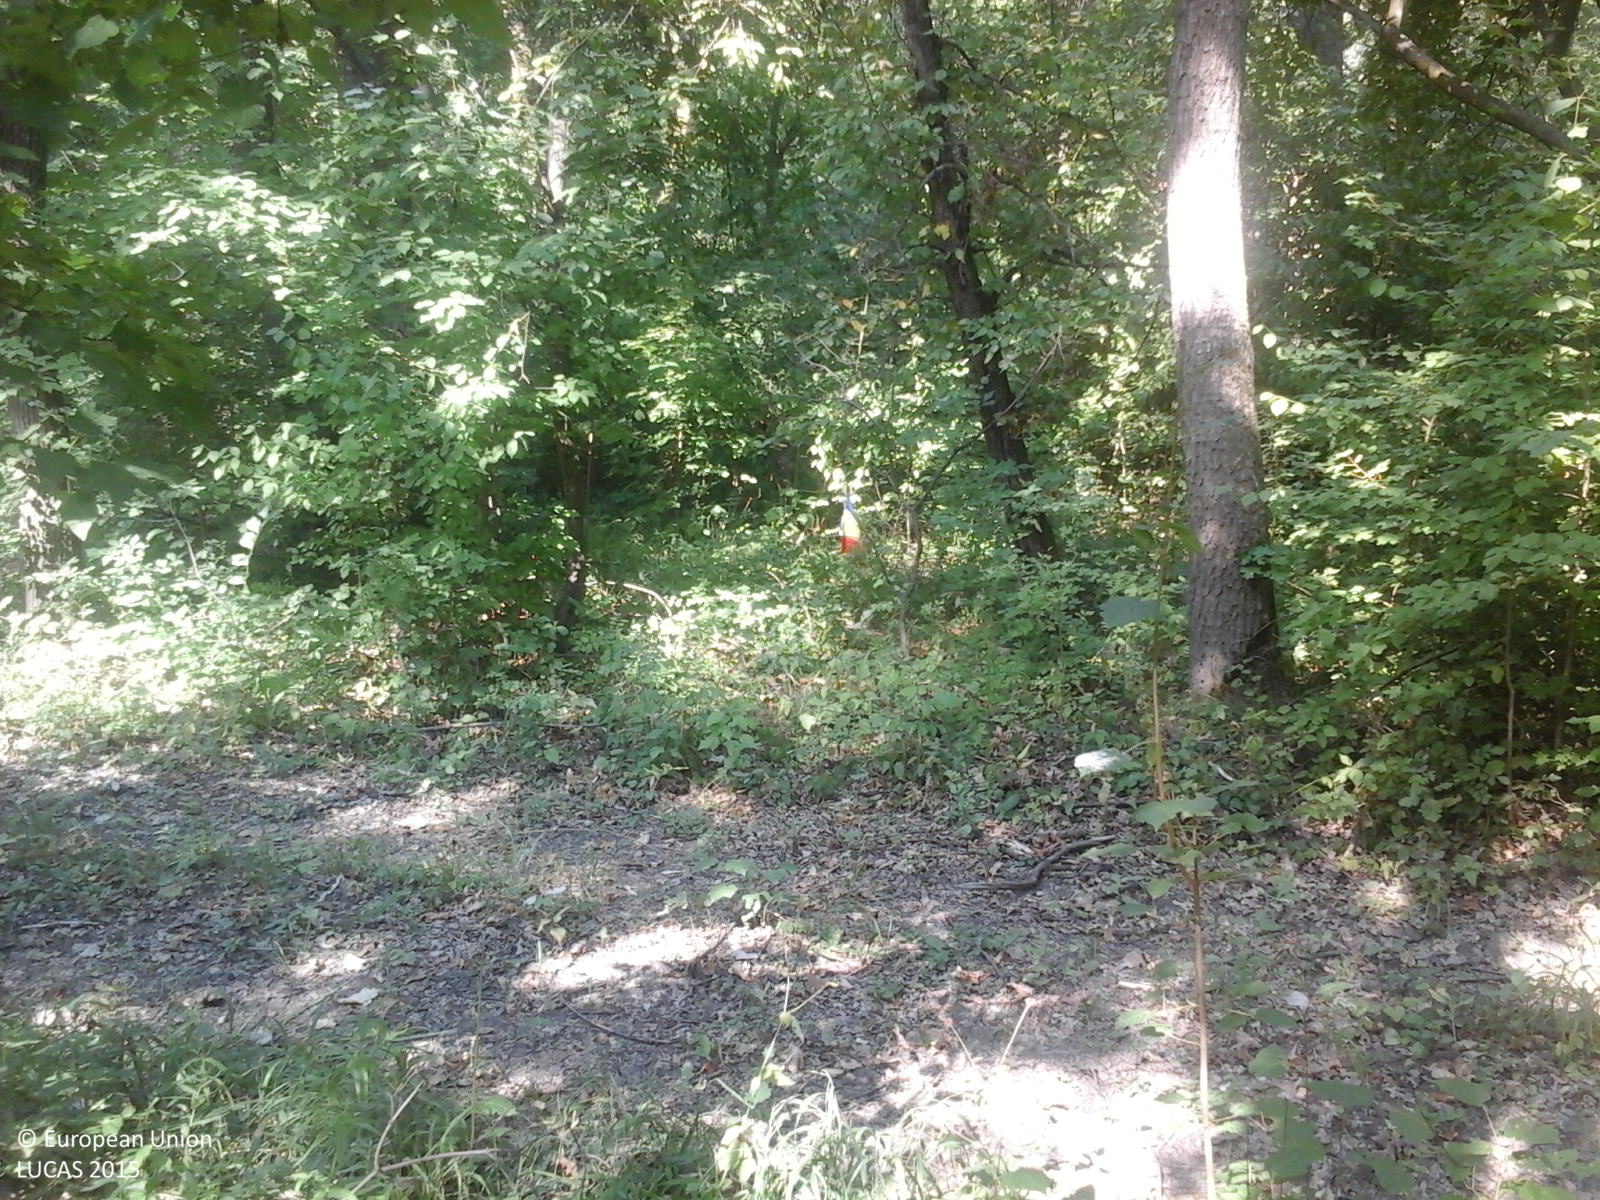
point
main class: Woodland
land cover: Broadleaved woodland
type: acidophilous oak and oak-birch forest
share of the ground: > 75 %
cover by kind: broadleaved forest trees 100 %
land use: Forestry
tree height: > 5 m
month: August
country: RO
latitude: 45.6896
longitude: 27.4770
